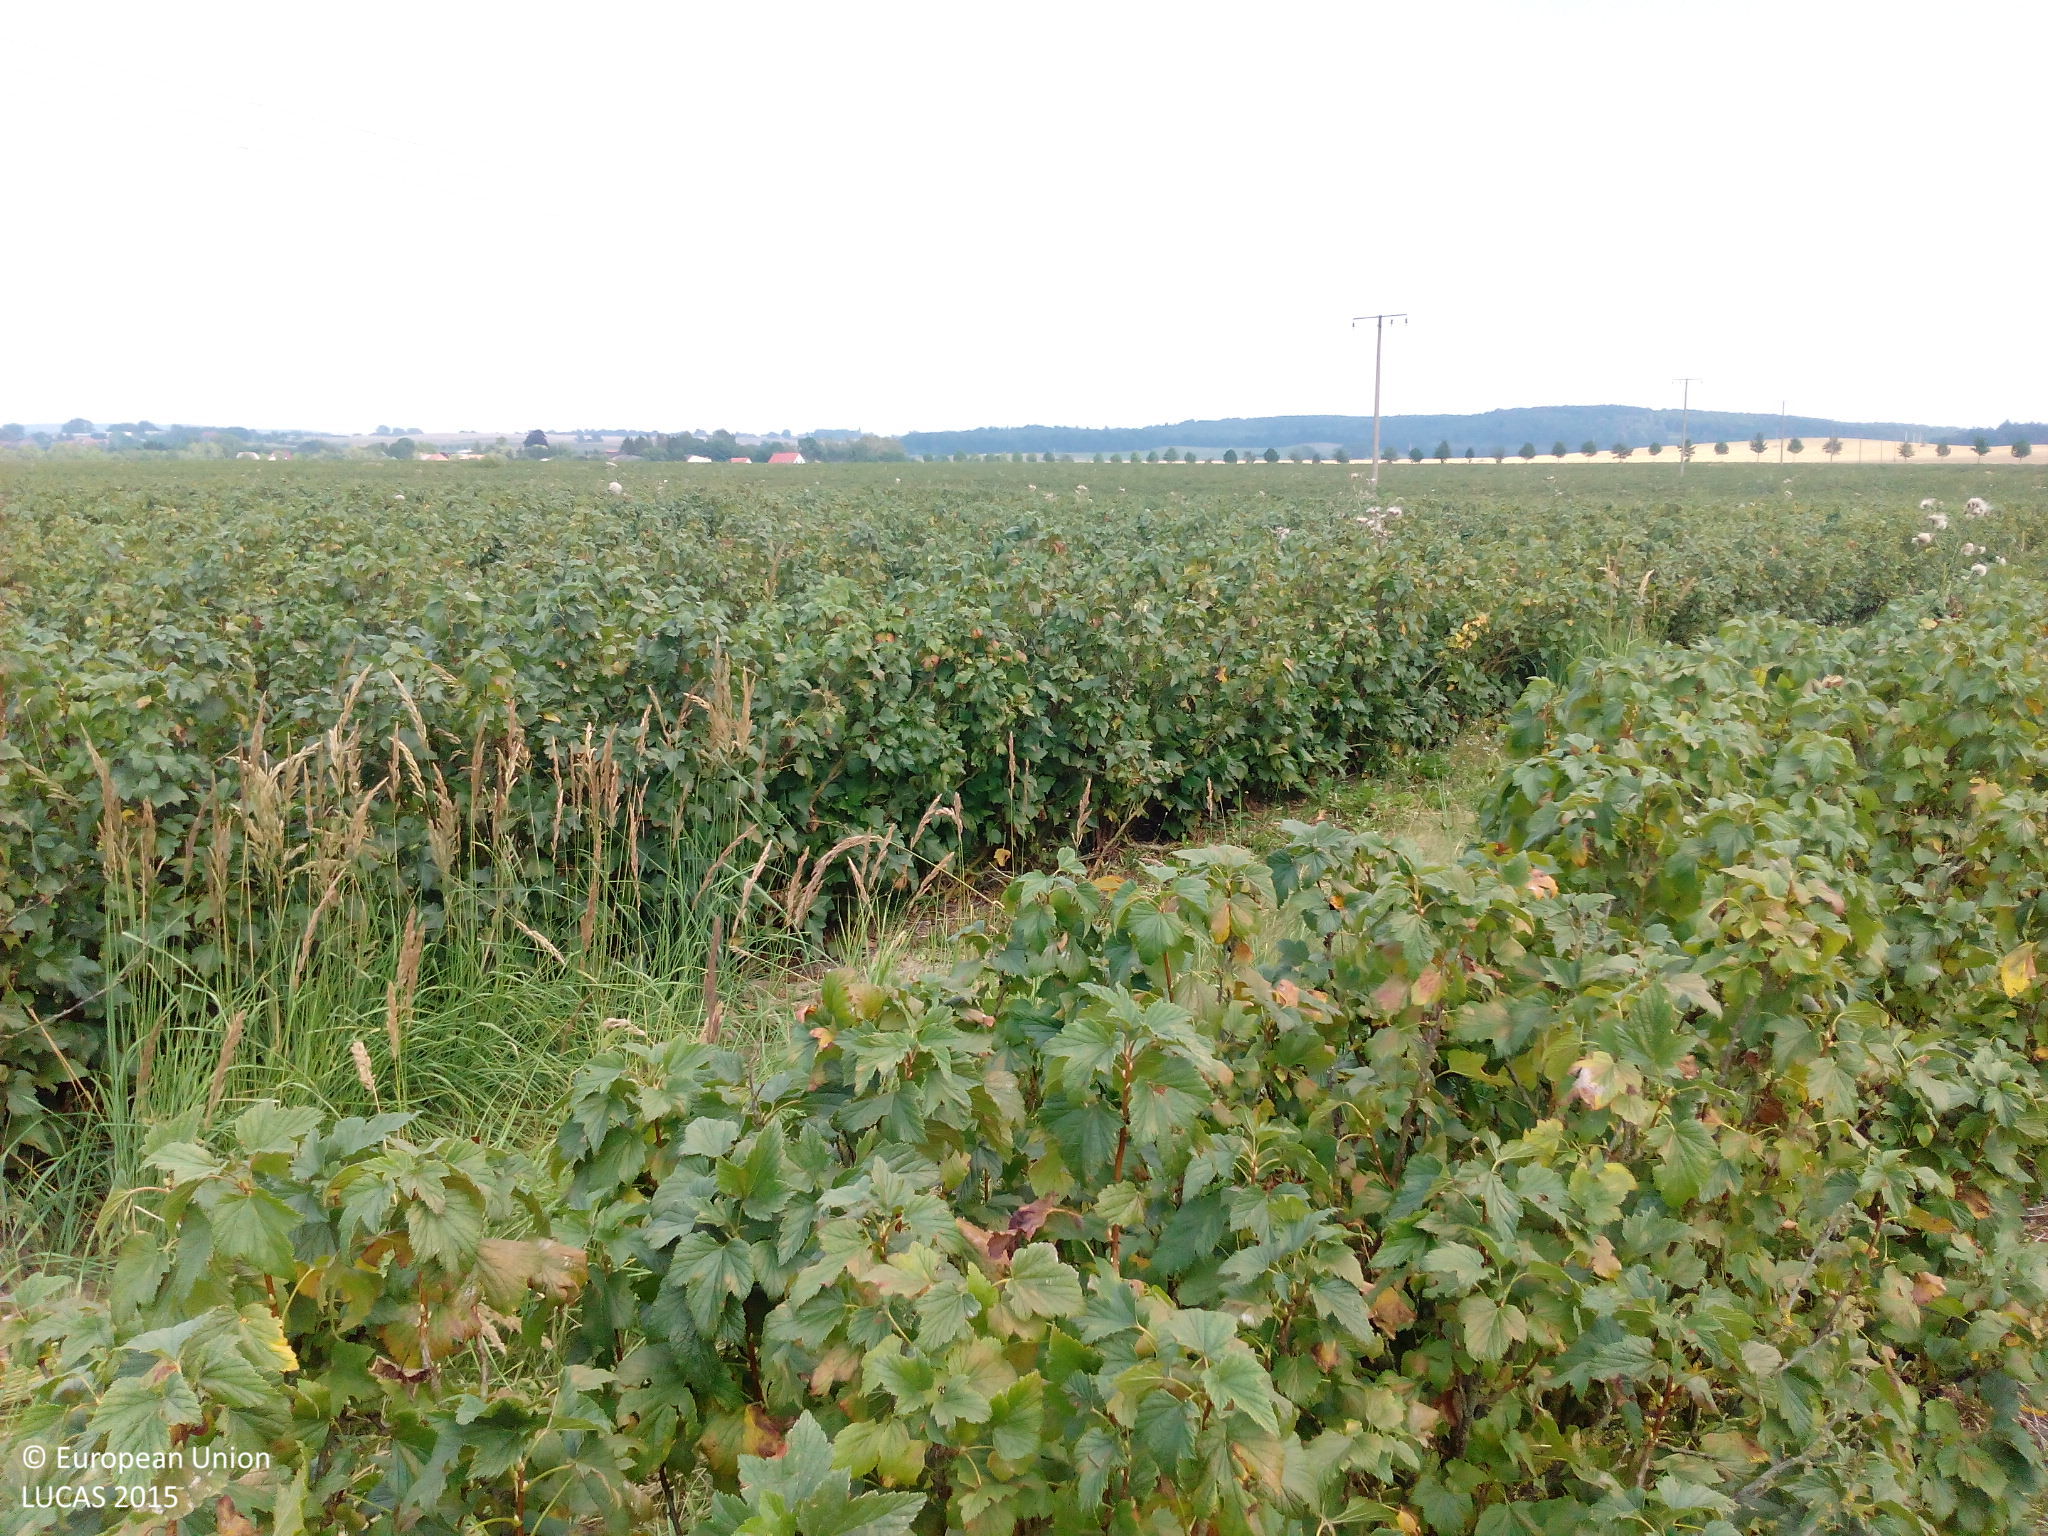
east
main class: Cropland
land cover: Other fruit trees and berries
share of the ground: > 75 %
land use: Agriculture (excluding fallow land and kitchen gardens)
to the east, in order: Other fruit trees and berries; Electric lines; Other fruit trees and berries
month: August
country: DE
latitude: 53.7518
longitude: 12.5925
